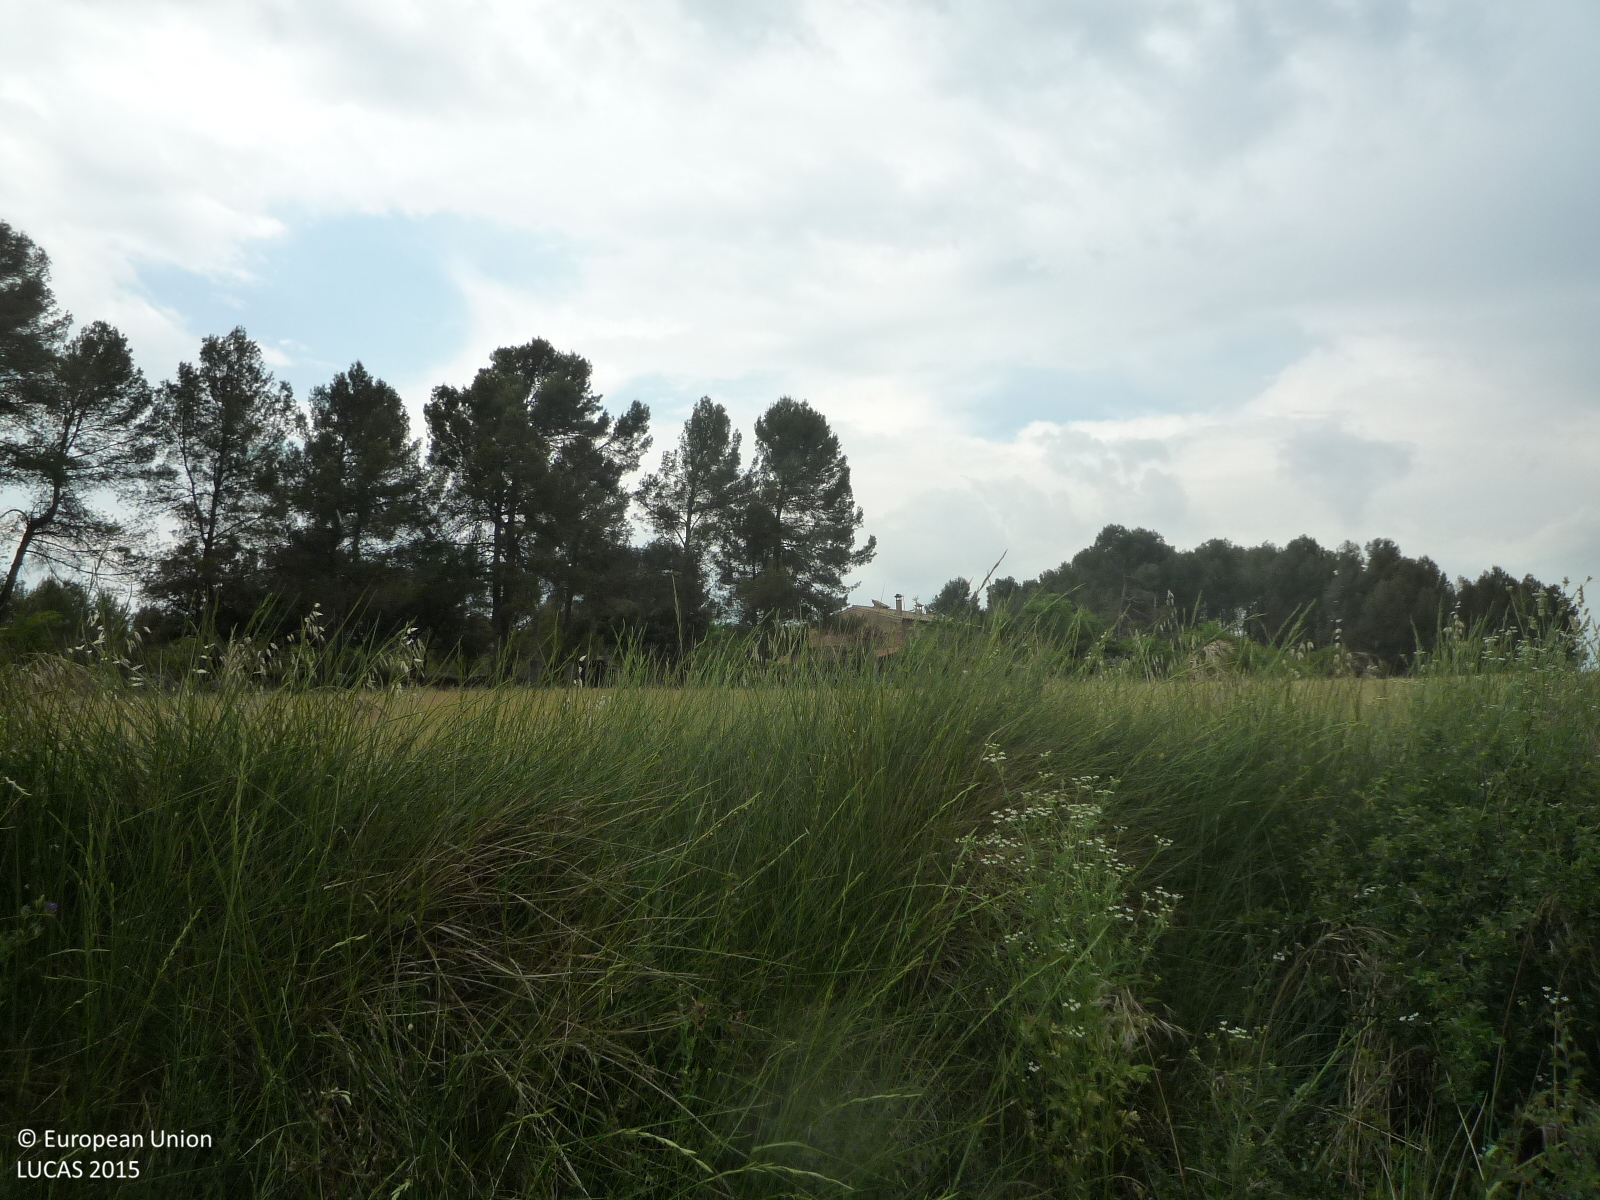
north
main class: Shrubland
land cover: Shrubland without tree cover
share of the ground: > 75 %
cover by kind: shrubs 70 %, herbaceous plants 30 %
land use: Semi-natural and natural areas not in use
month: June
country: ES
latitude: 41.8477
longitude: 2.0055
